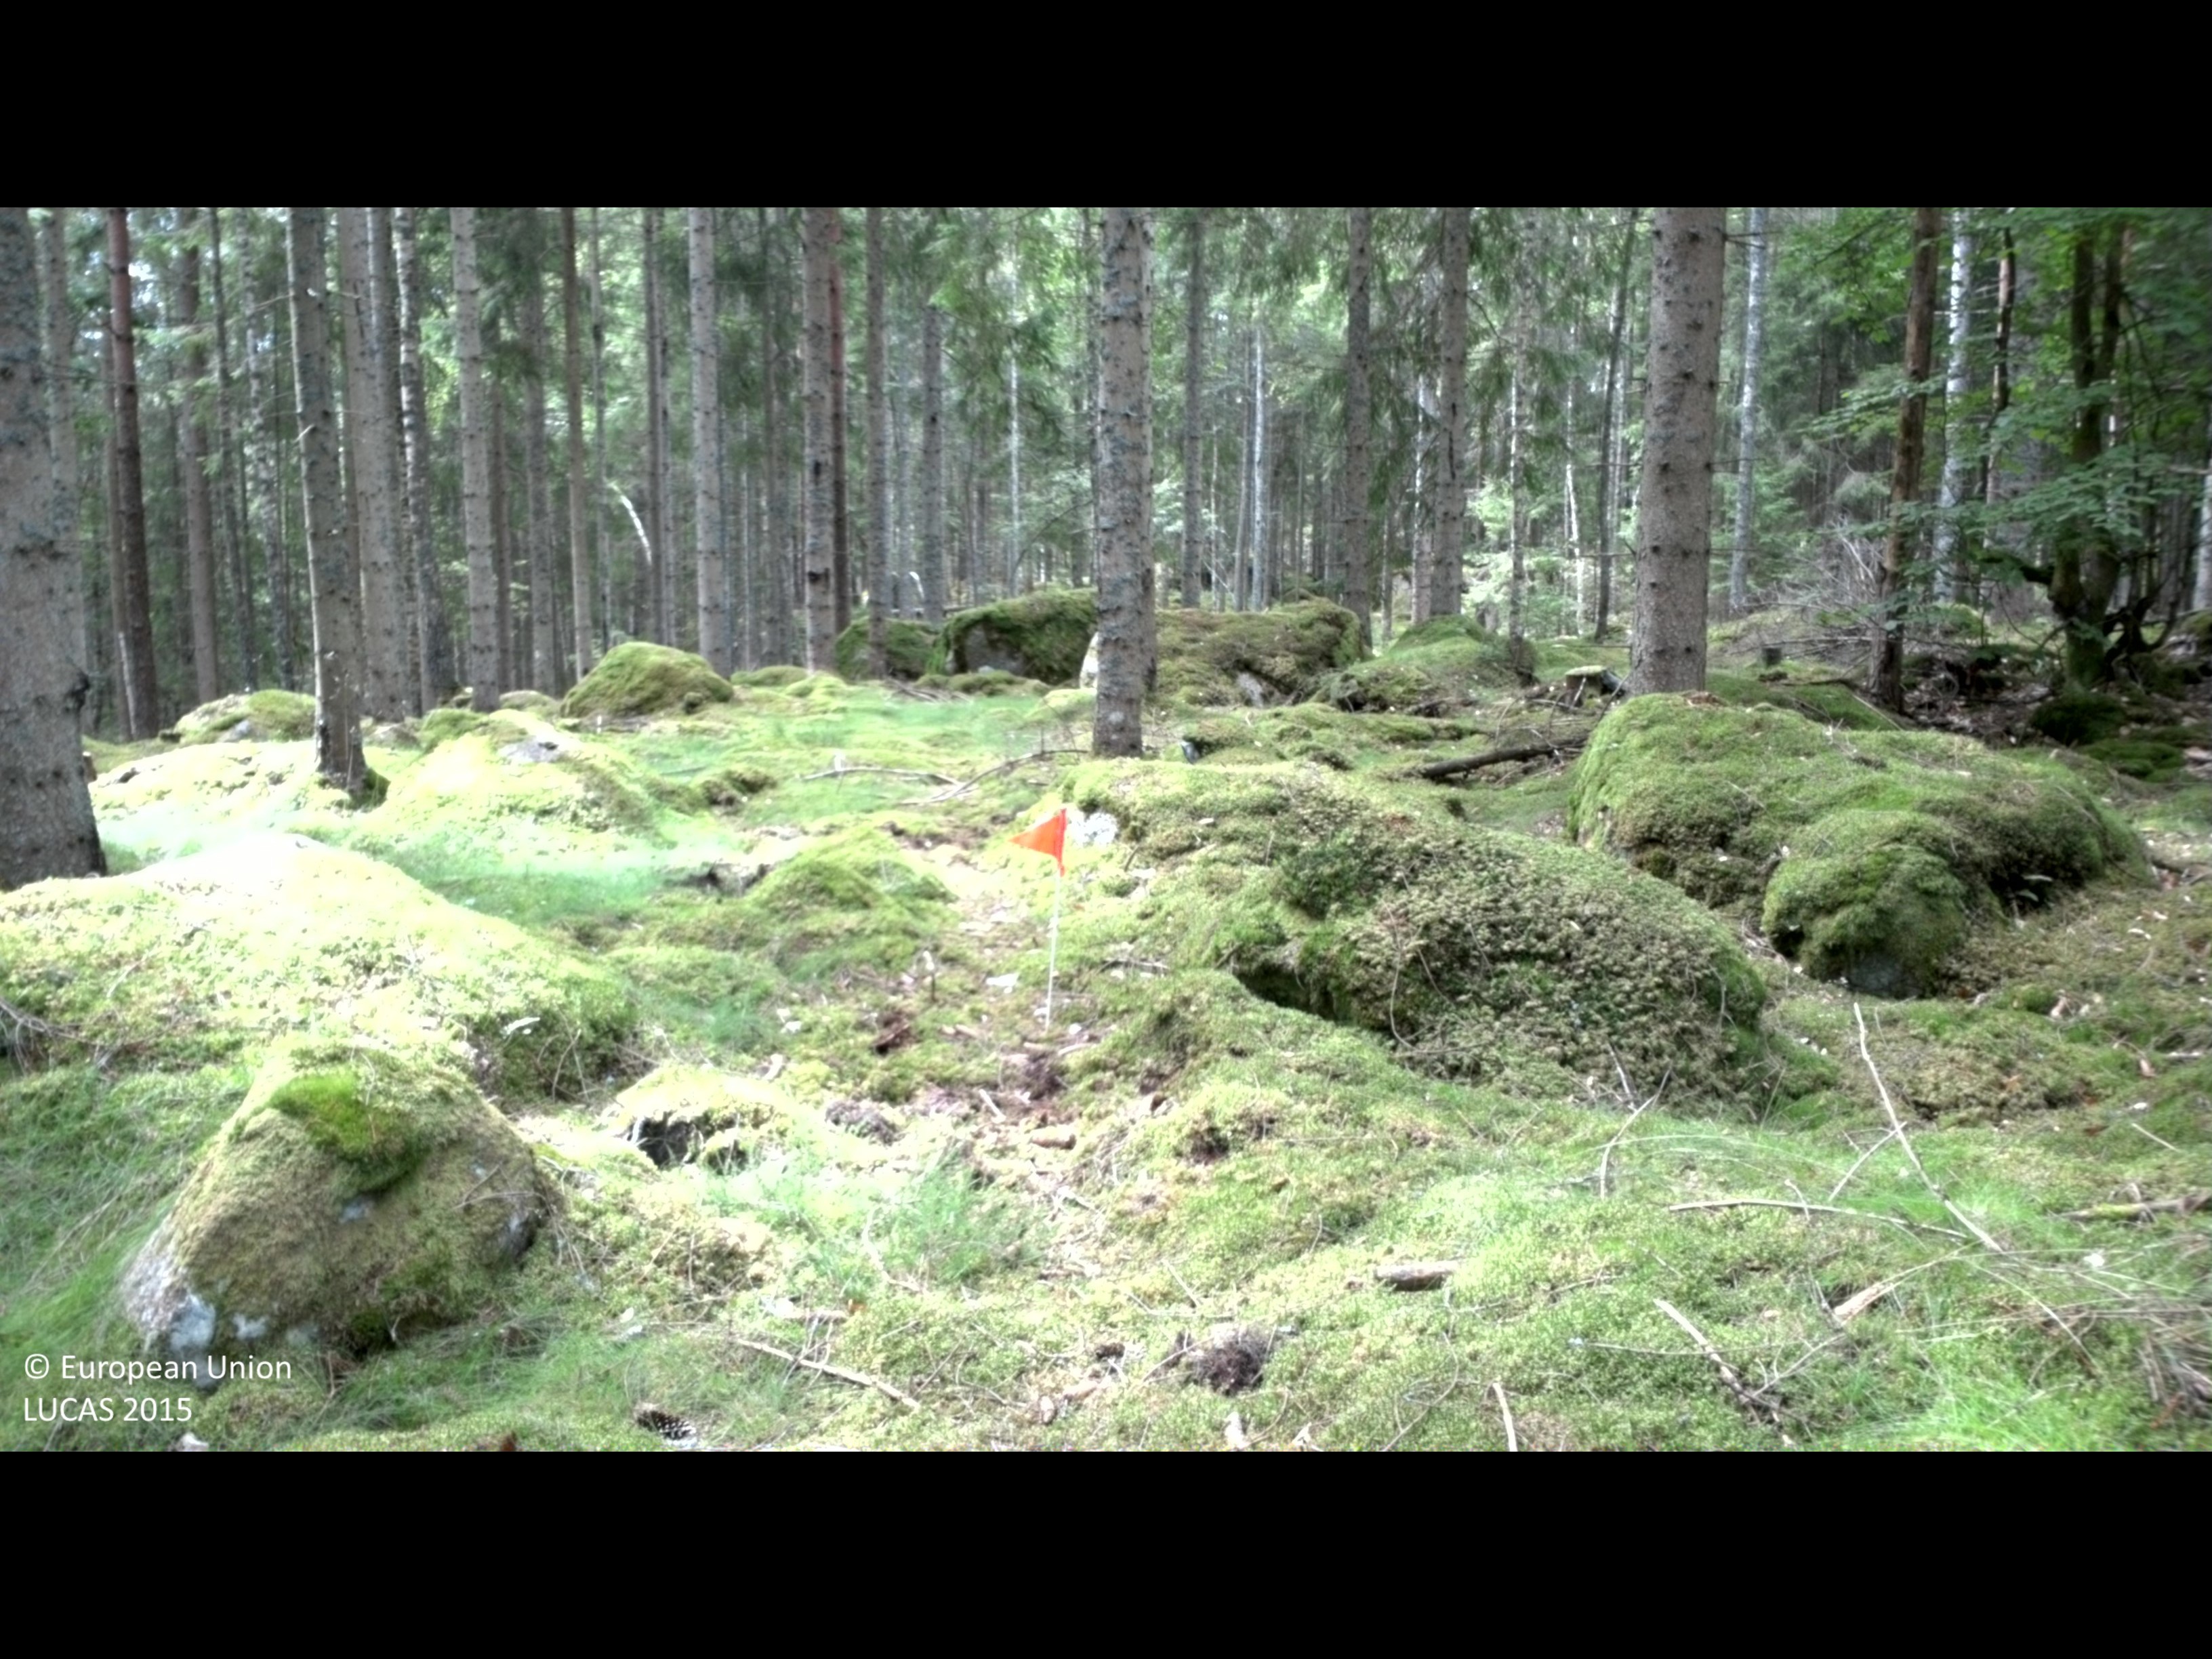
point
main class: Woodland
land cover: Spruce dominated coniferous woodland
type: boreal forest
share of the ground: > 75 %
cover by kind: coniferous forest trees 75 %, lichens and mosses 25 %
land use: Forestry
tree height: > 5 m
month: August
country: SE
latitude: 56.4312
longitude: 14.5543
